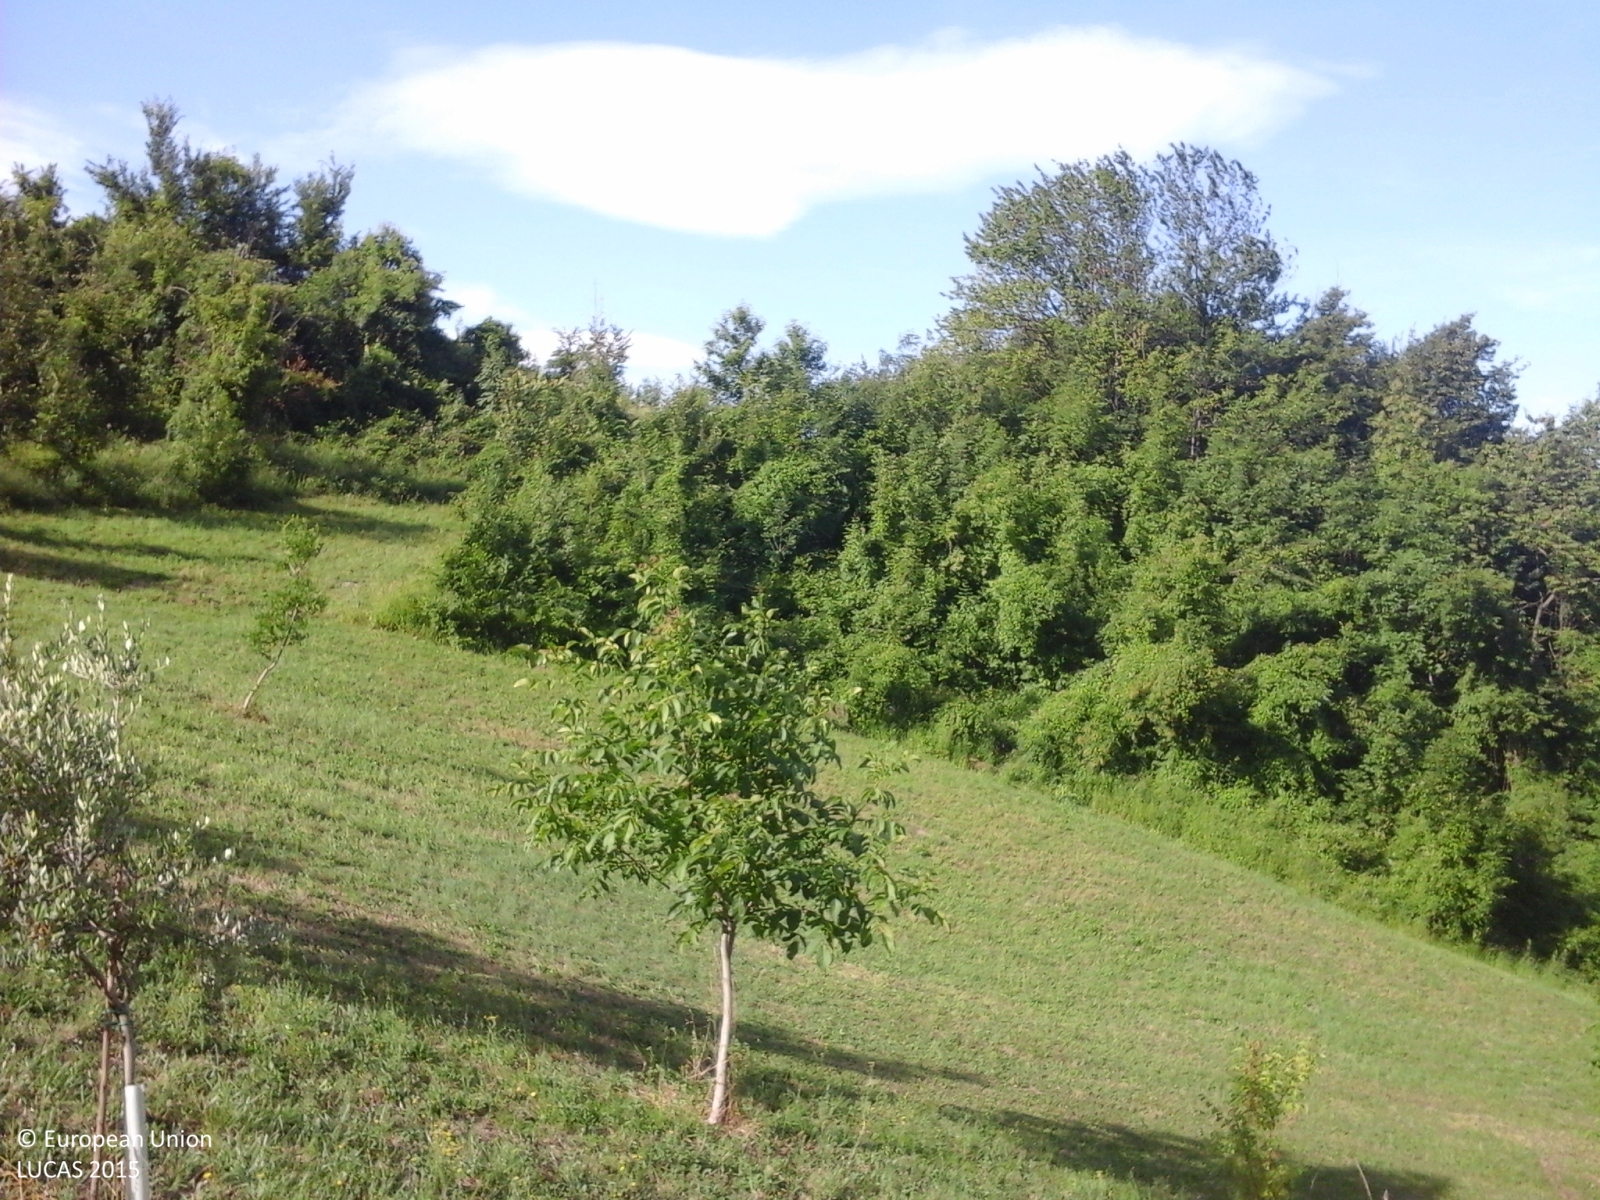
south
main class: Grassland
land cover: Grassland with sparse tree/shrub cover
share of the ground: > 75 %
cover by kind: herbaceous plants 95 %, broadleaved forest trees 5 %
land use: Agriculture (excluding fallow land and kitchen gardens)
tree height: > 5 m
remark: Clear cut
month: June
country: IT
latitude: 44.6205
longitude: 10.3395
